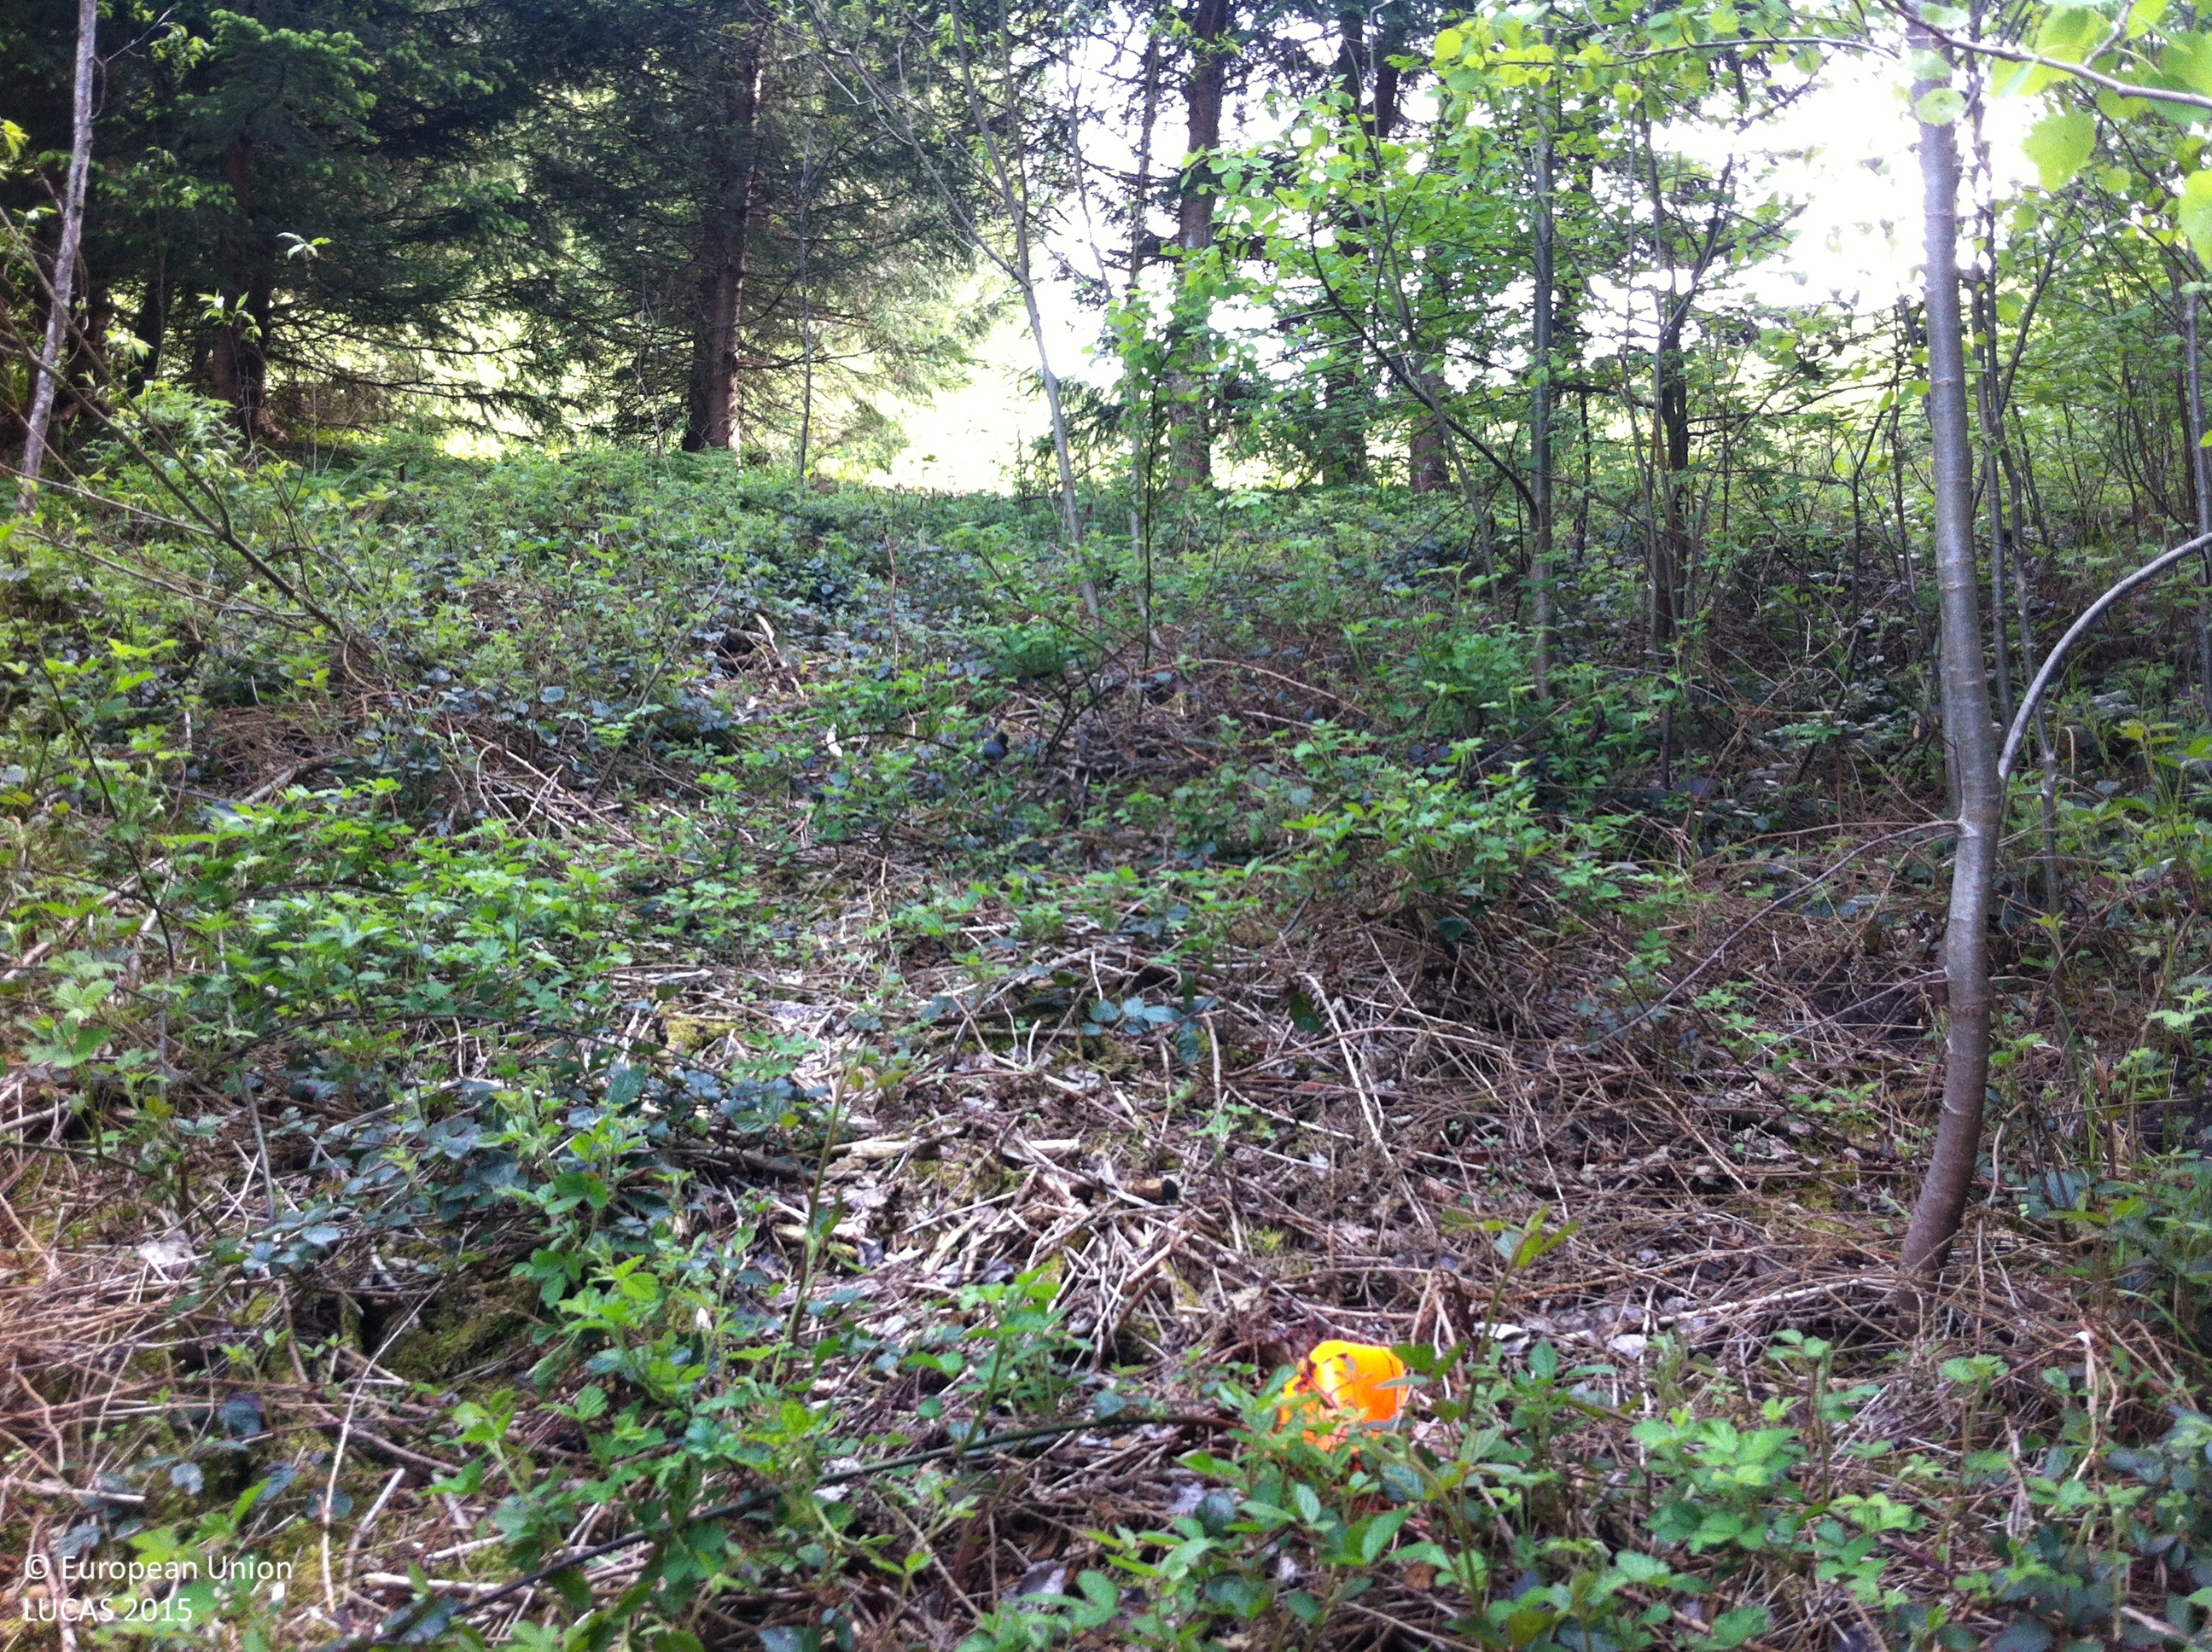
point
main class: Woodland
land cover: Broadleaved woodland
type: mesophytic deciduous forest
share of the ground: 50 - 75 %
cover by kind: broadleaved forest trees 70 %, shrubs 20 %, herbaceous plants 10 %
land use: Forestry
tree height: > 5 m
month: May
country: AT
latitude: 47.3282
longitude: 11.7055
